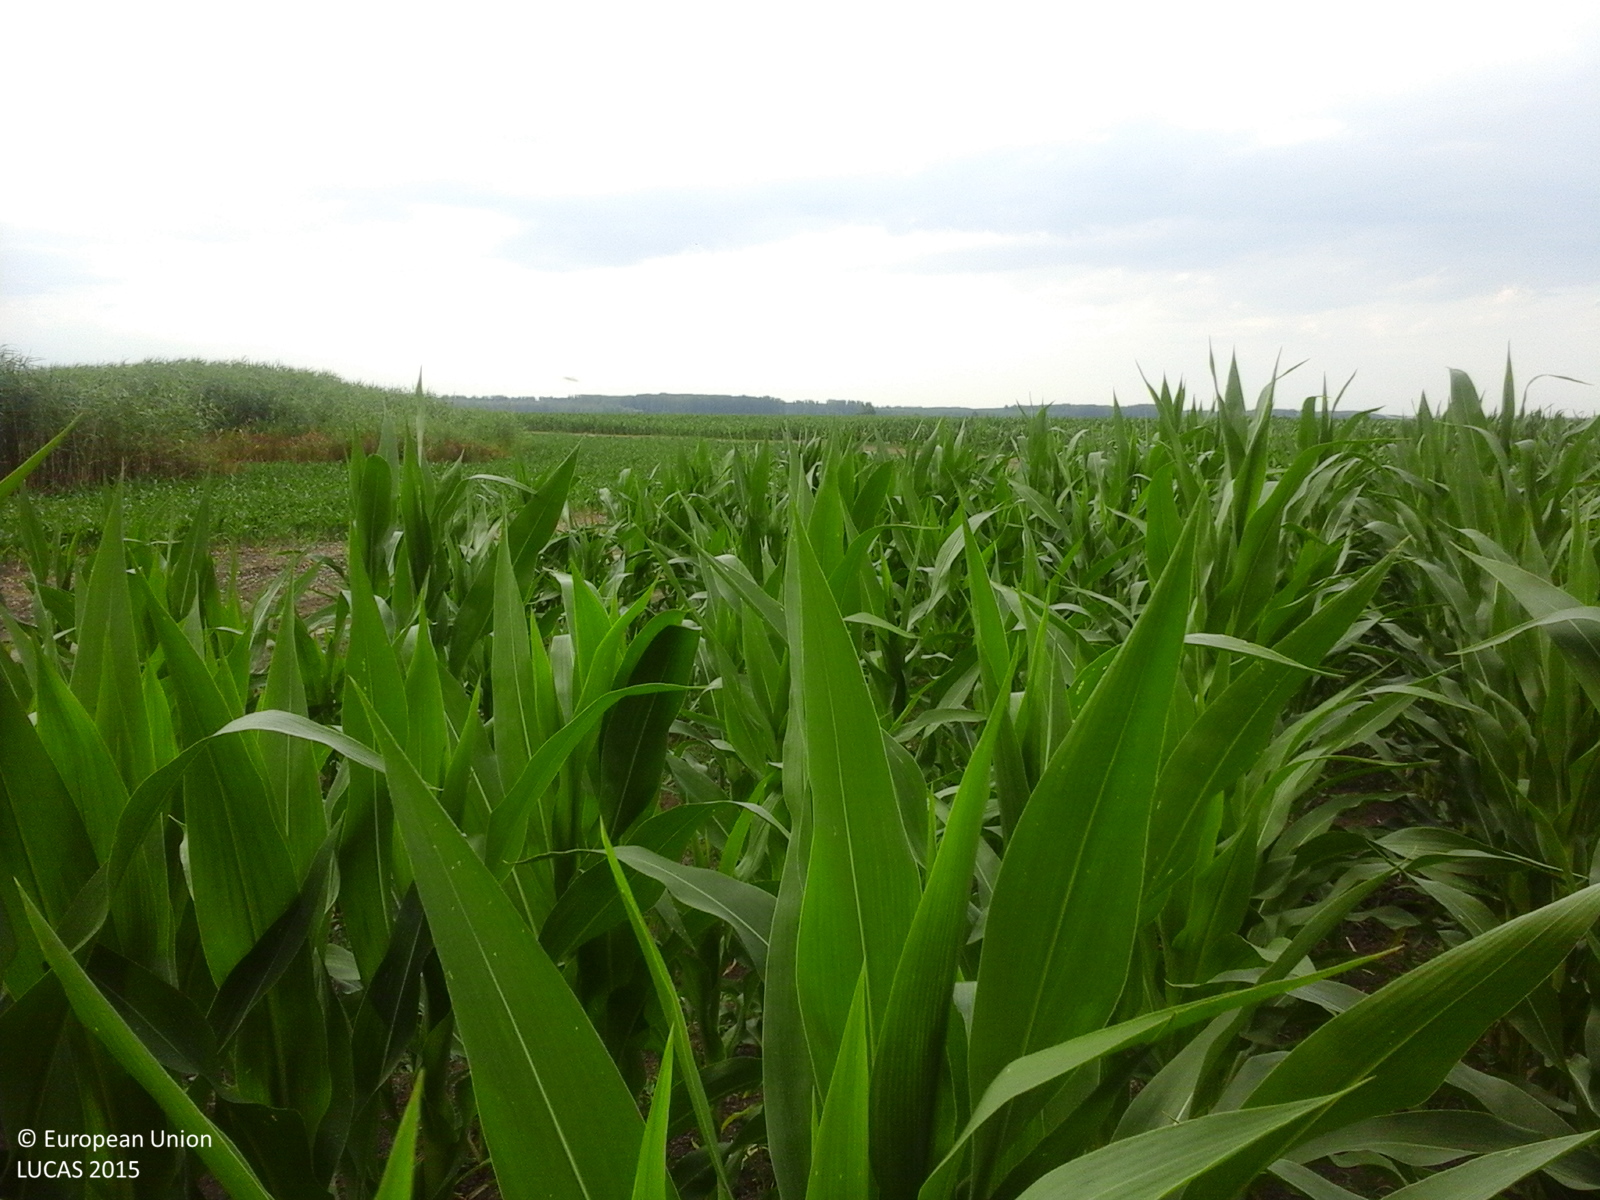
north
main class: Cropland
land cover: Maize
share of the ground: > 75 %
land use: Agriculture (excluding fallow land and kitchen gardens)
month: June
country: RO
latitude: 44.0211
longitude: 26.2090
